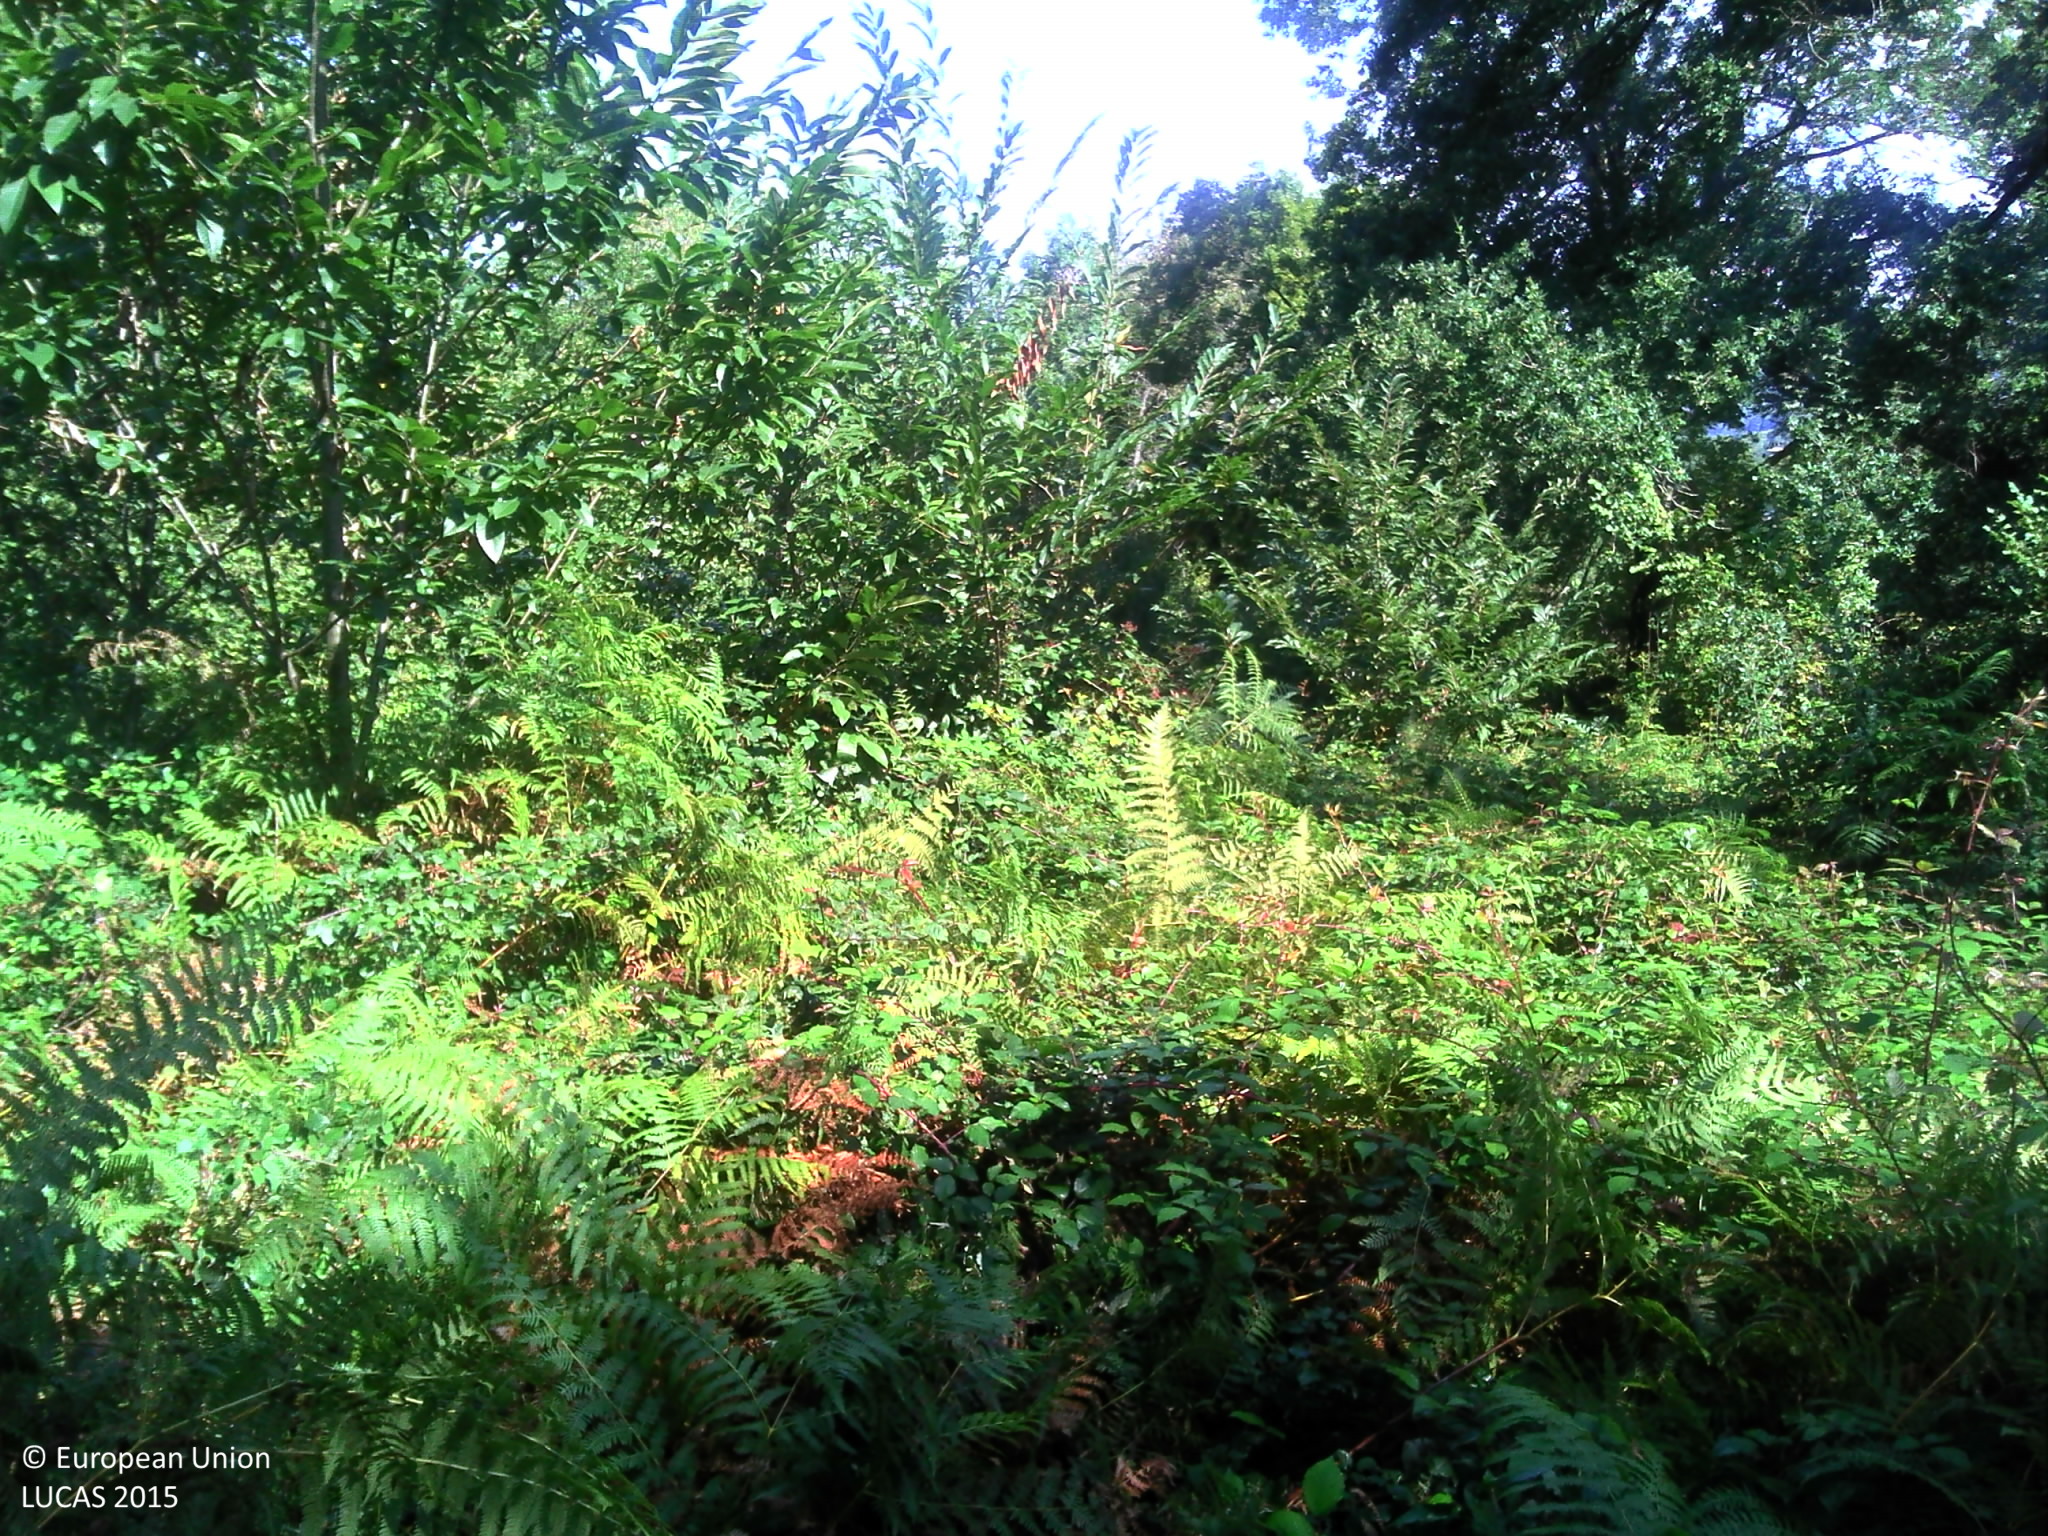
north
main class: Shrubland
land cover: Shrubland with sparse tree cover
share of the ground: > 75 %
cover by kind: shrubs 55 %, herbaceous plants 40 %, broadleaved forest trees 5 %
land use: Semi-natural and natural areas not in use
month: September
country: FR
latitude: 43.1033
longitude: -0.8839
